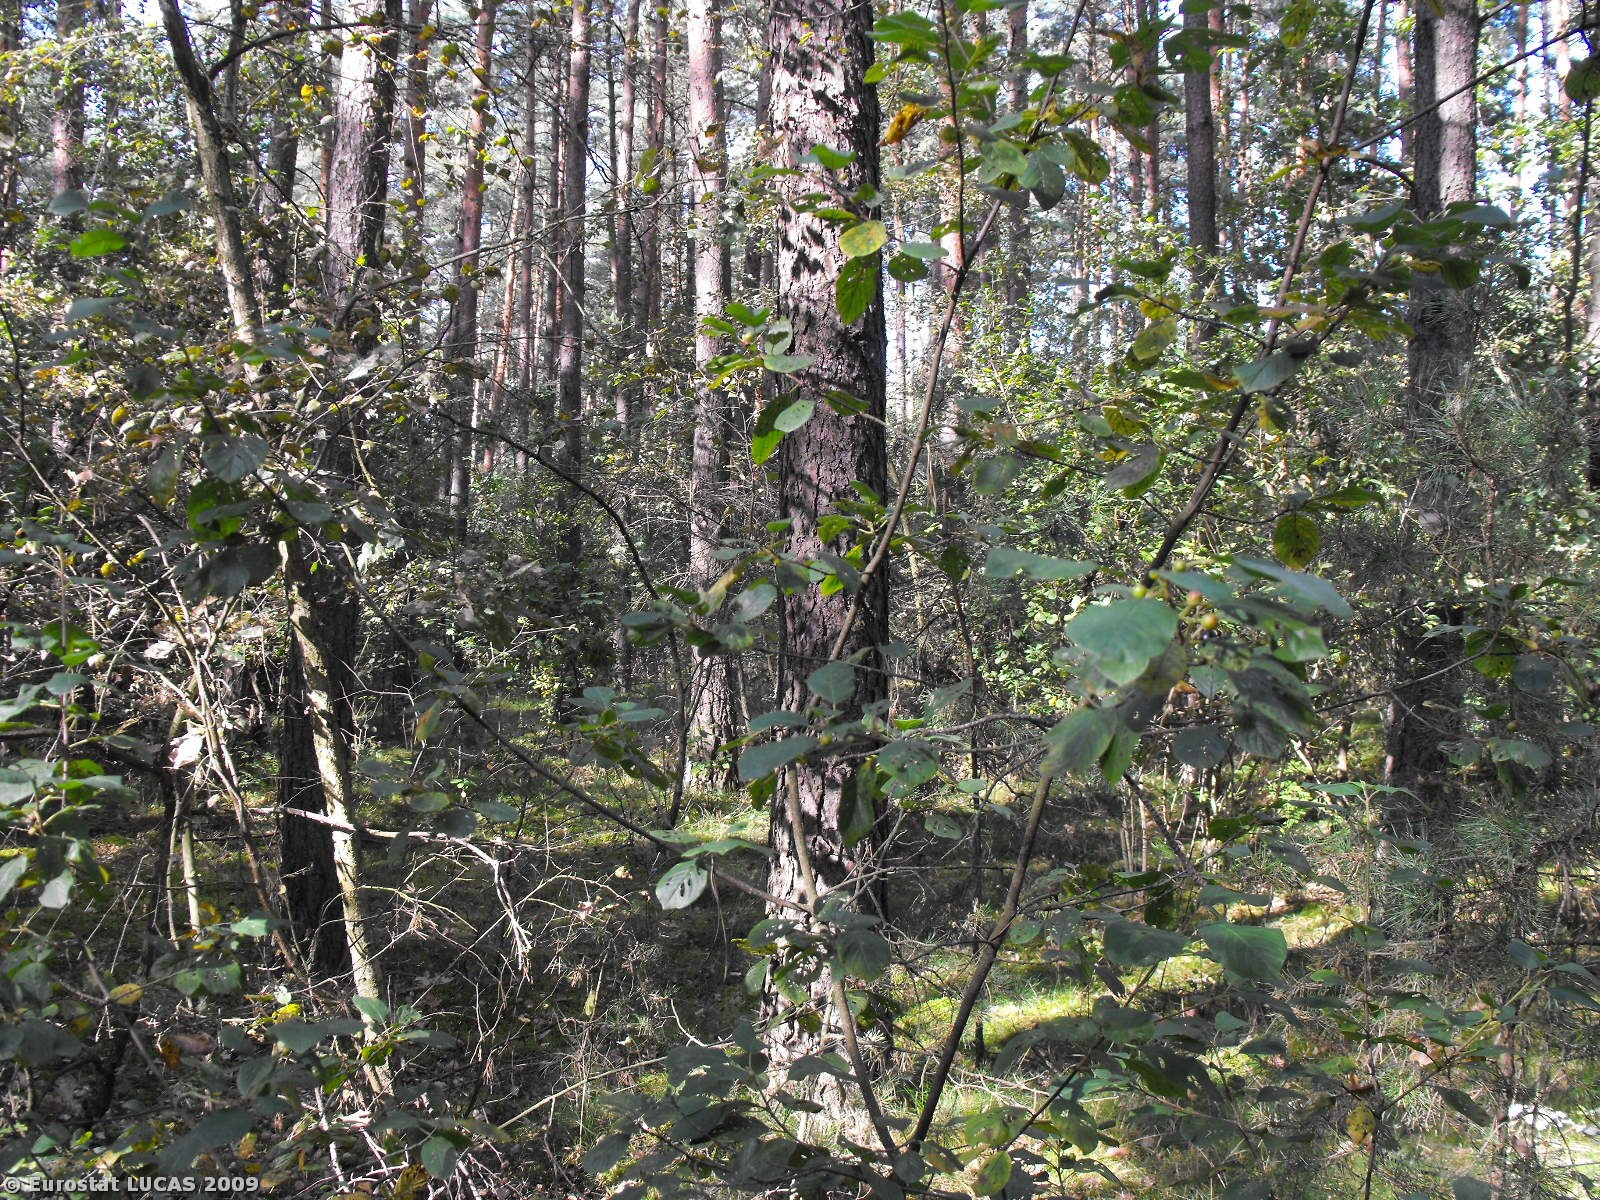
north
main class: Woodland
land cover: Coniferous woodland
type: hemiboreal forest and nemoral coniferous forest and mixed broadleaved-coniferous forest
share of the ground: > 75 %
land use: Forestry
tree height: > 5 m
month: September
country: PL
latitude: 52.8357
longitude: 16.4048
